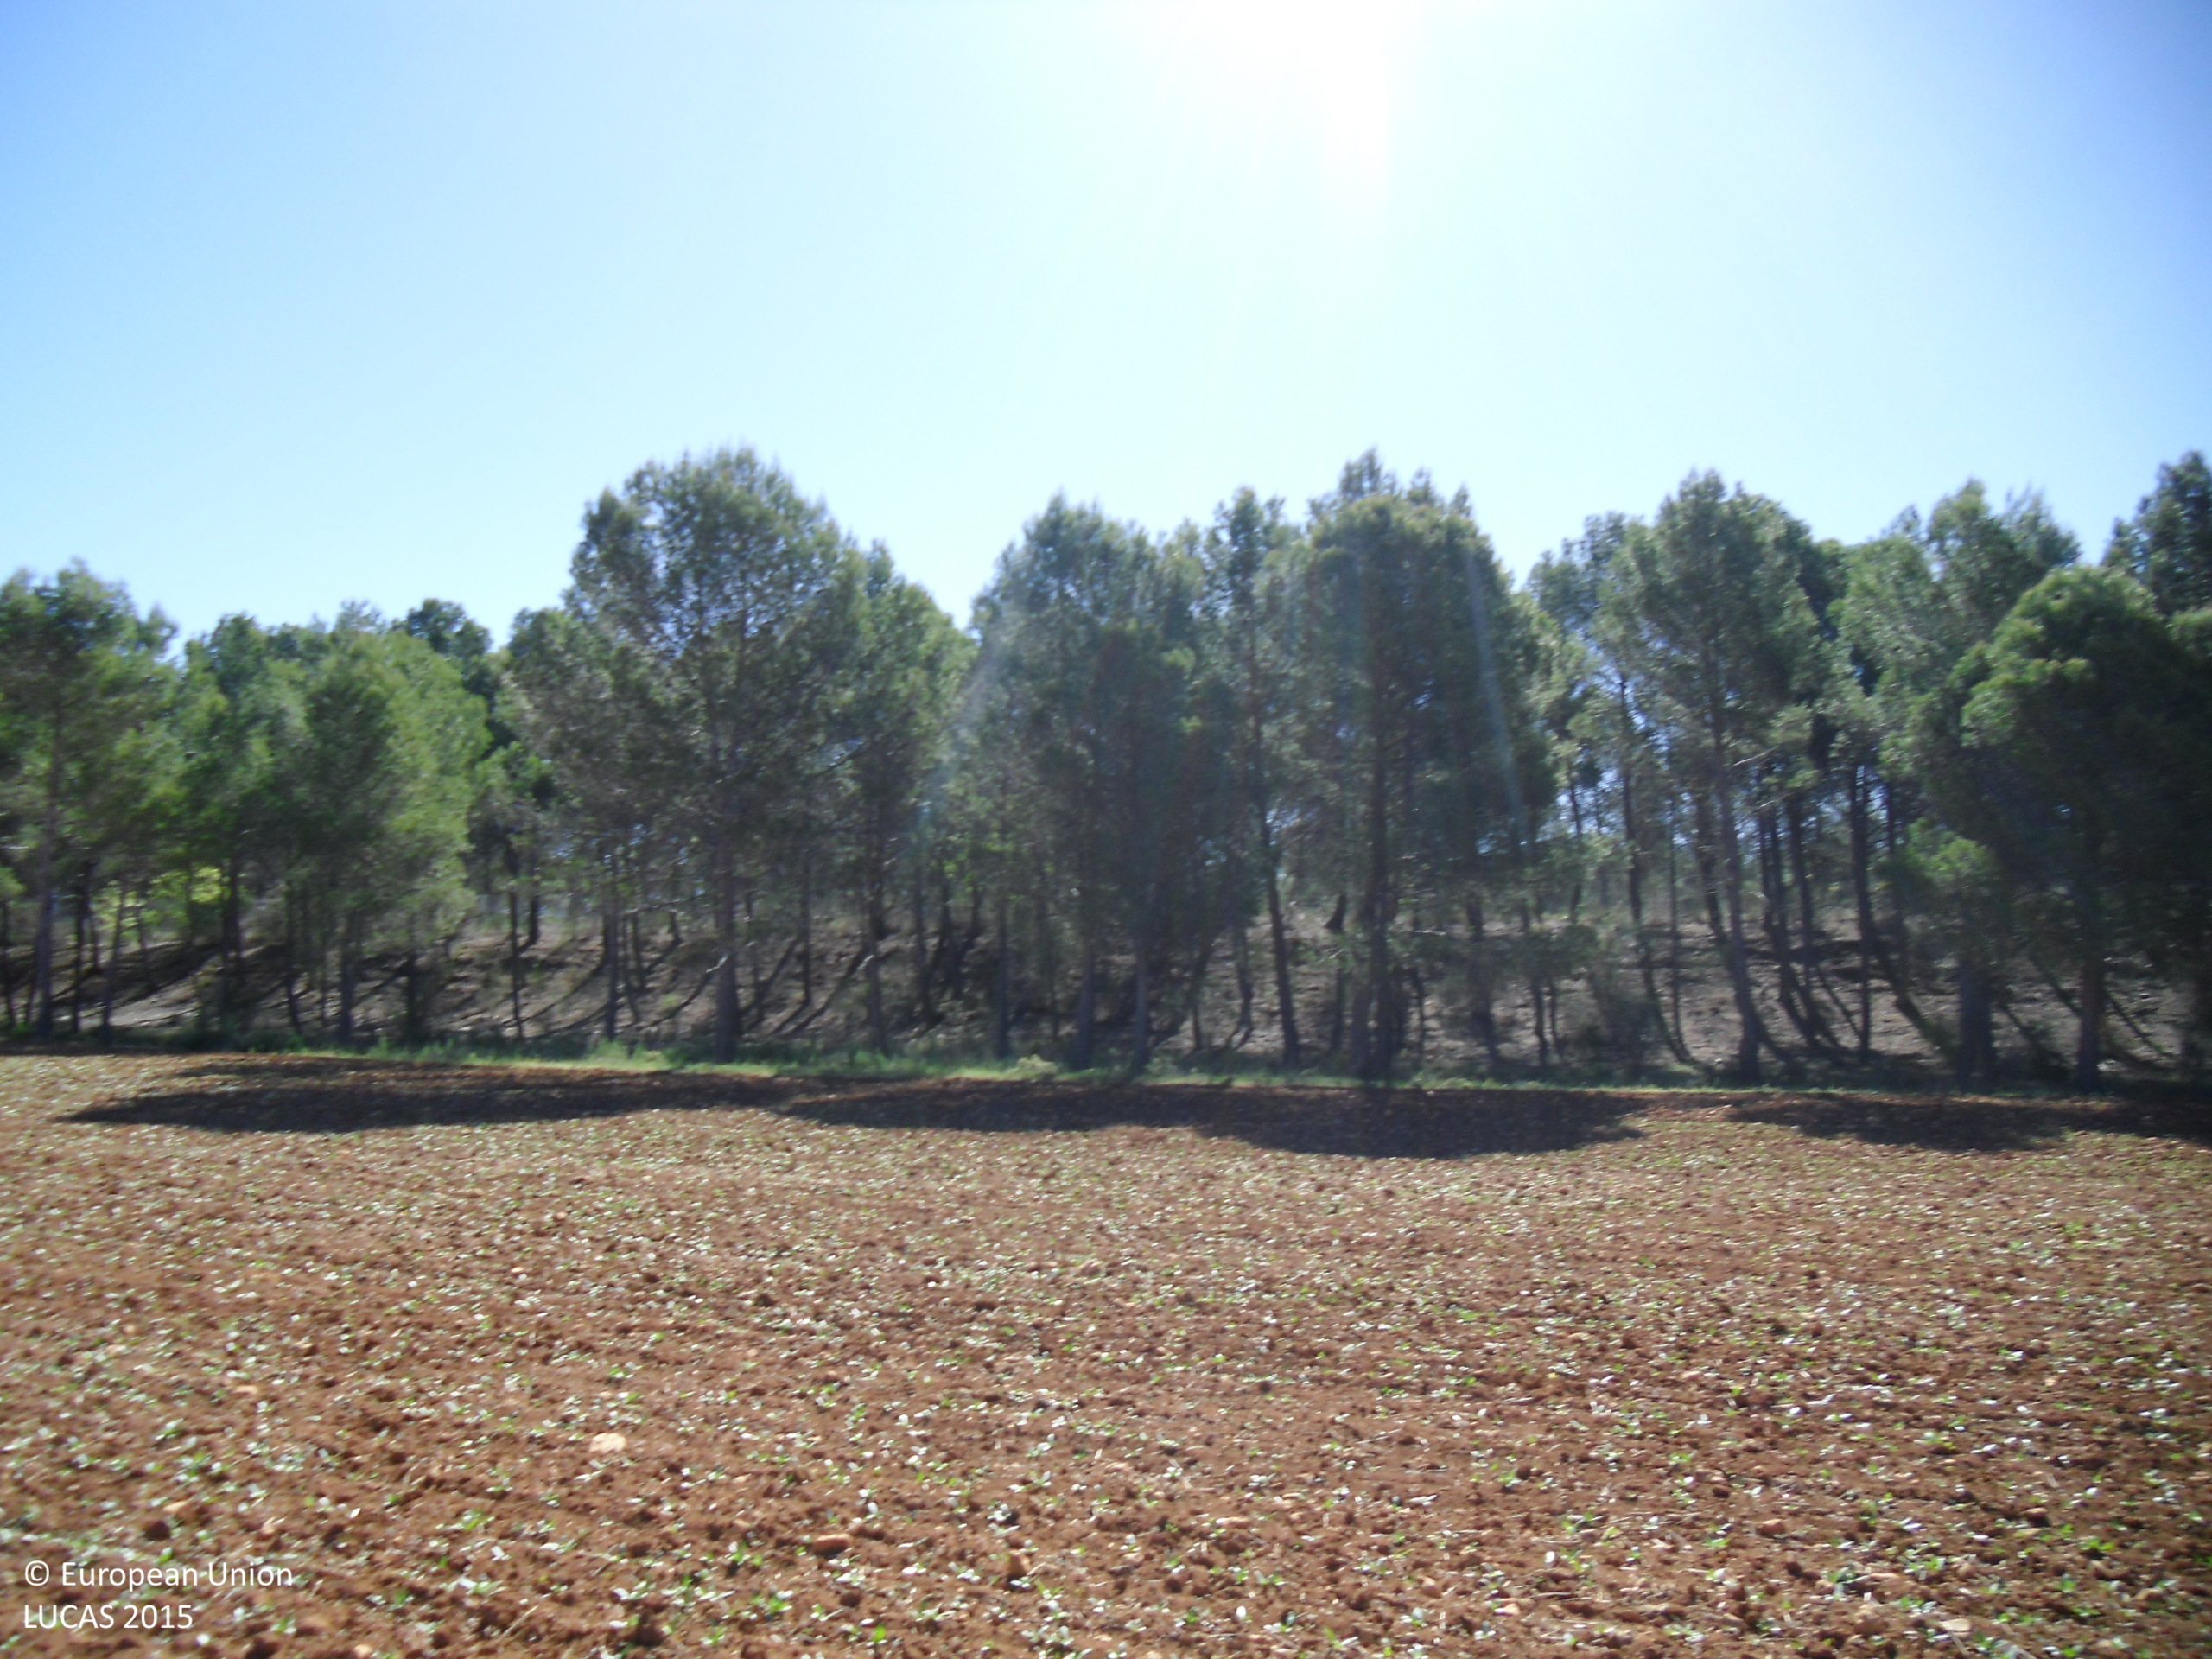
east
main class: Cropland
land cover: Soya
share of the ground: < 10 %
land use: Agriculture (excluding fallow land and kitchen gardens)
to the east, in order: Soya; Grass margins; Pine dominated coniferous woodland; Shruby margins; Paved roads, cycling and walking lanes; Grass margins; Fences; Inland fresh running water; Grass margins; Fences; Pine dominated coniferous woodland; Barley
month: May
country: ES
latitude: 40.2031
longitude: -2.8654
